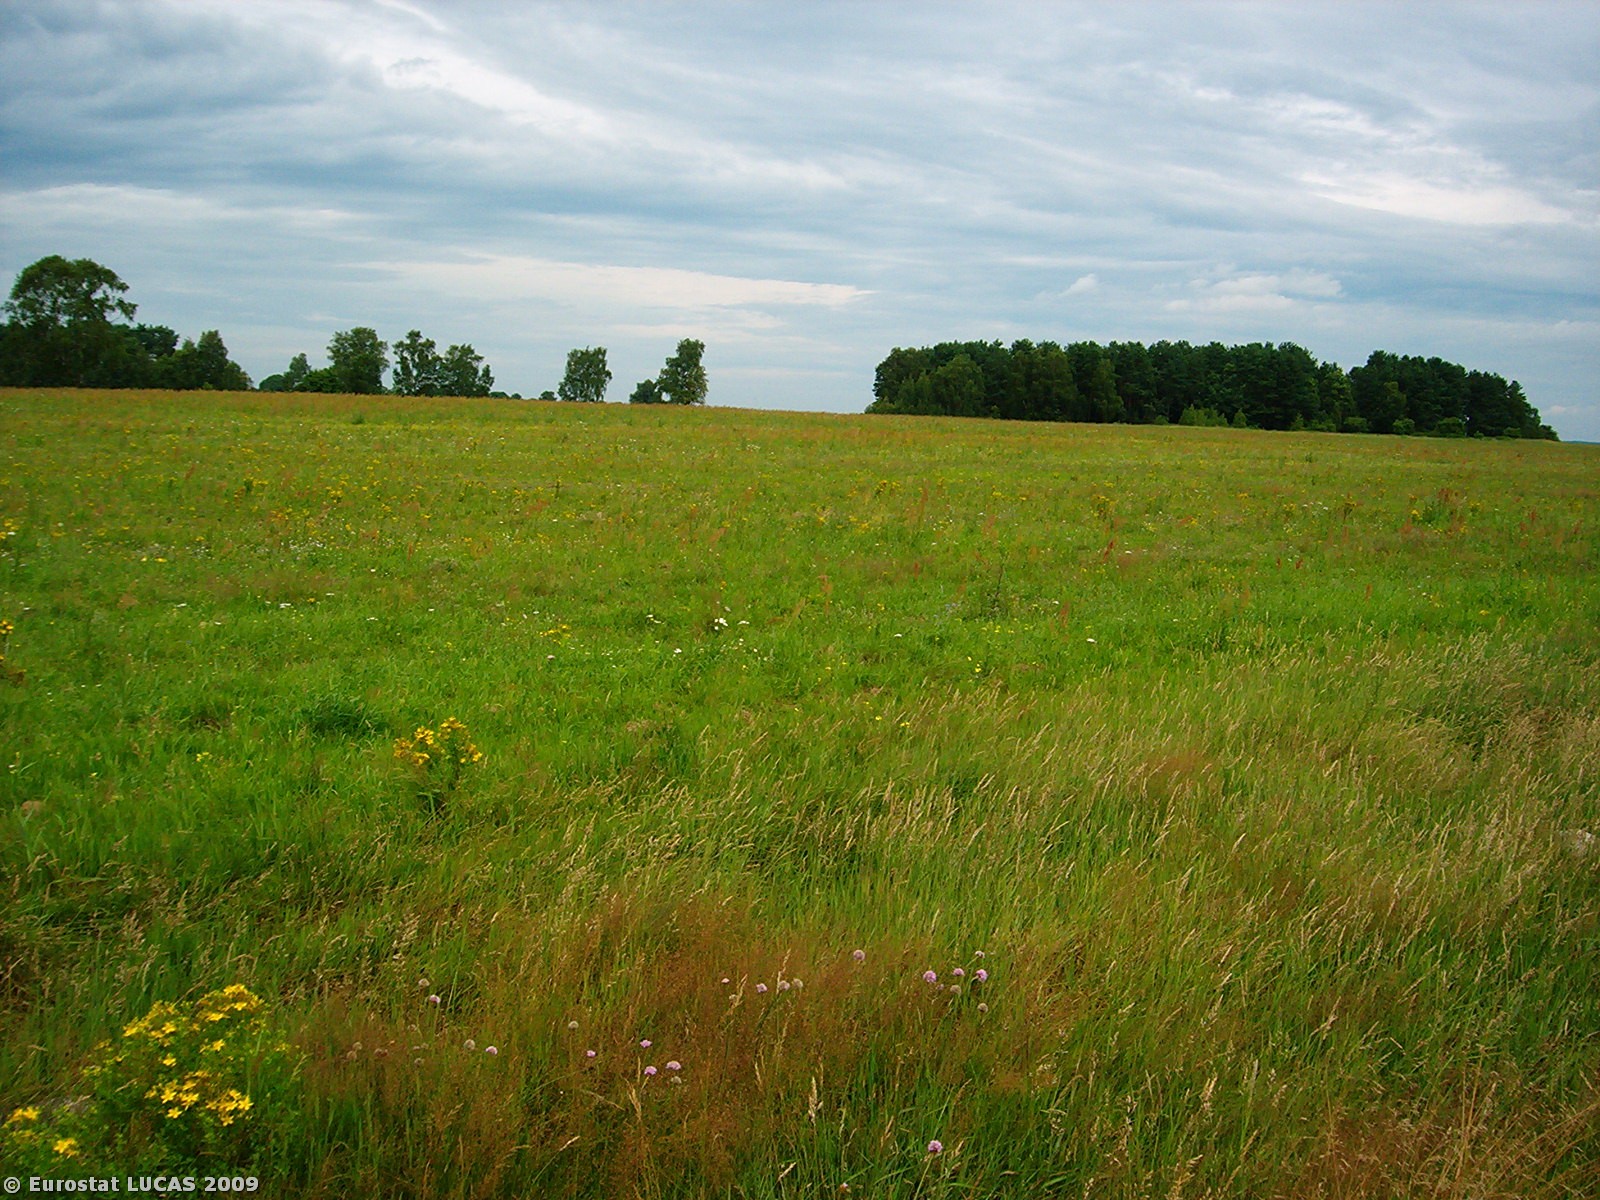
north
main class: Cropland
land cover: Triticale
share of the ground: > 75 %
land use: Agriculture (excluding fallow land and kitchen gardens)
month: July
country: PL
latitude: 52.3184
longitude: 15.1817
